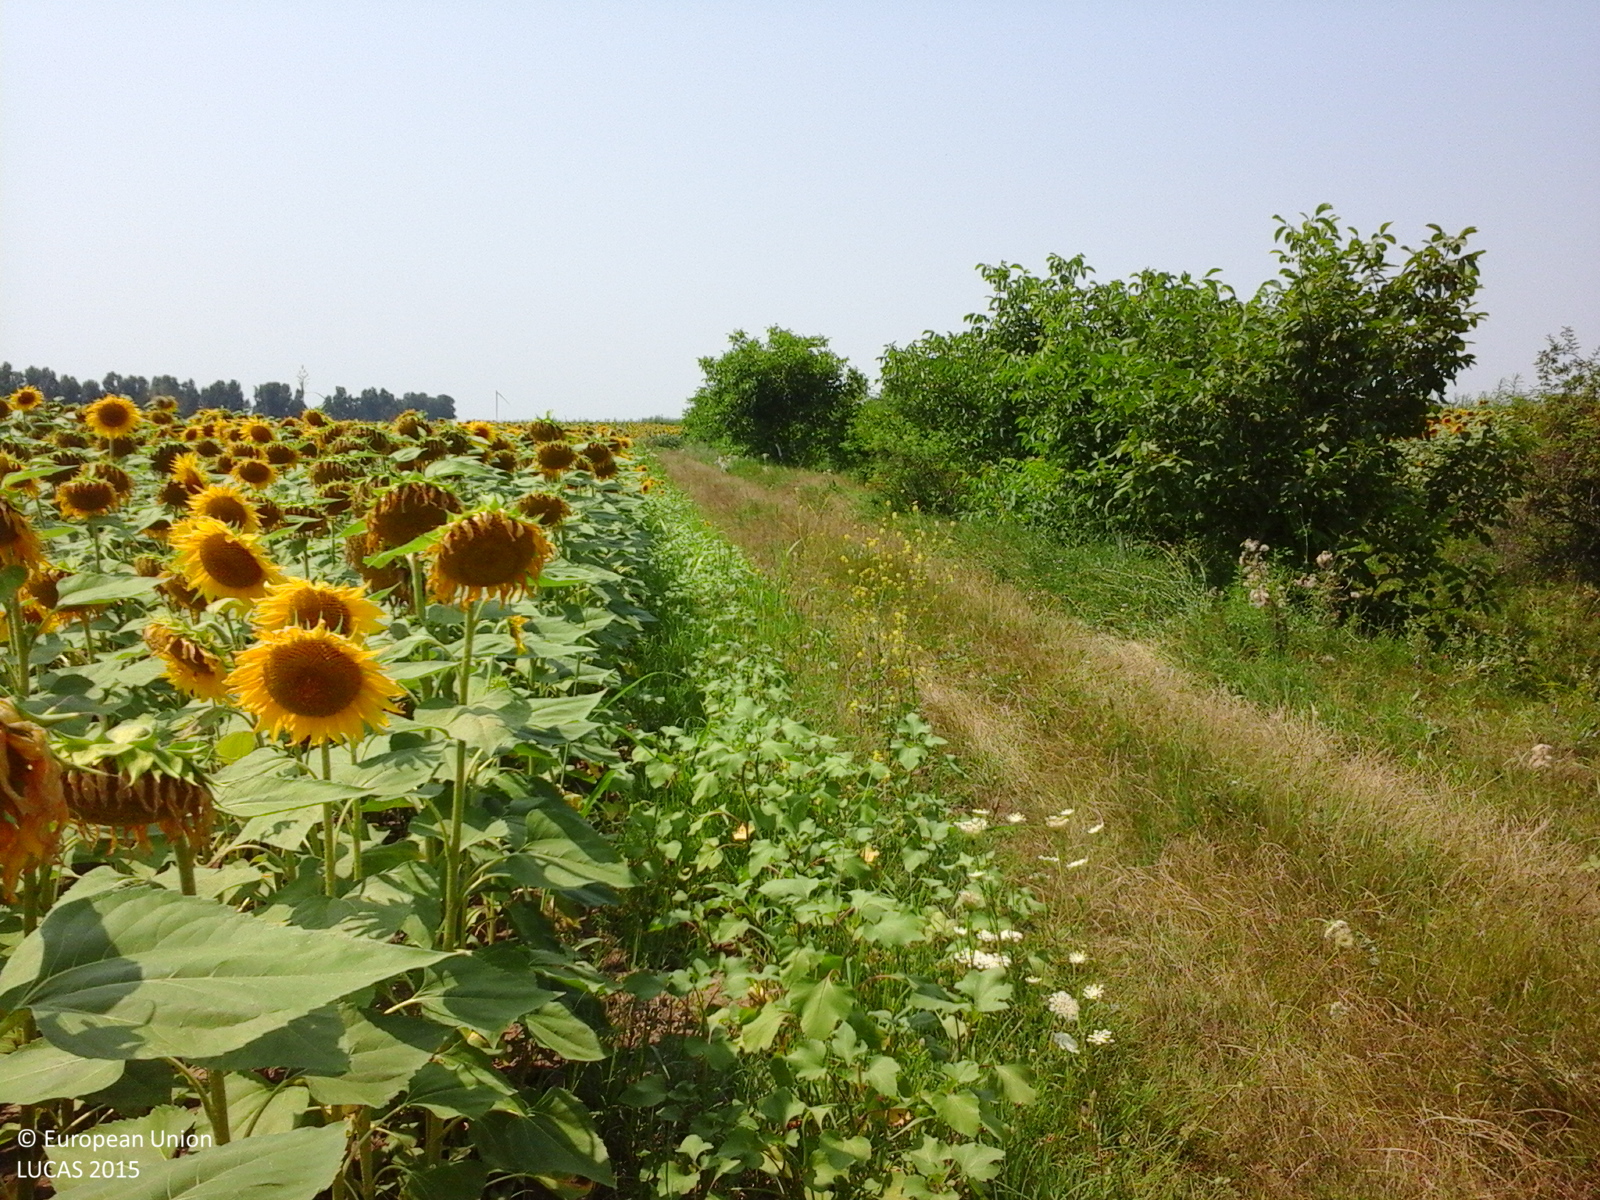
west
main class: Cropland
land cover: Sunflower
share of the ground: > 75 %
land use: Agriculture (excluding fallow land and kitchen gardens)
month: July
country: RO
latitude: 44.7251
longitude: 26.2860
